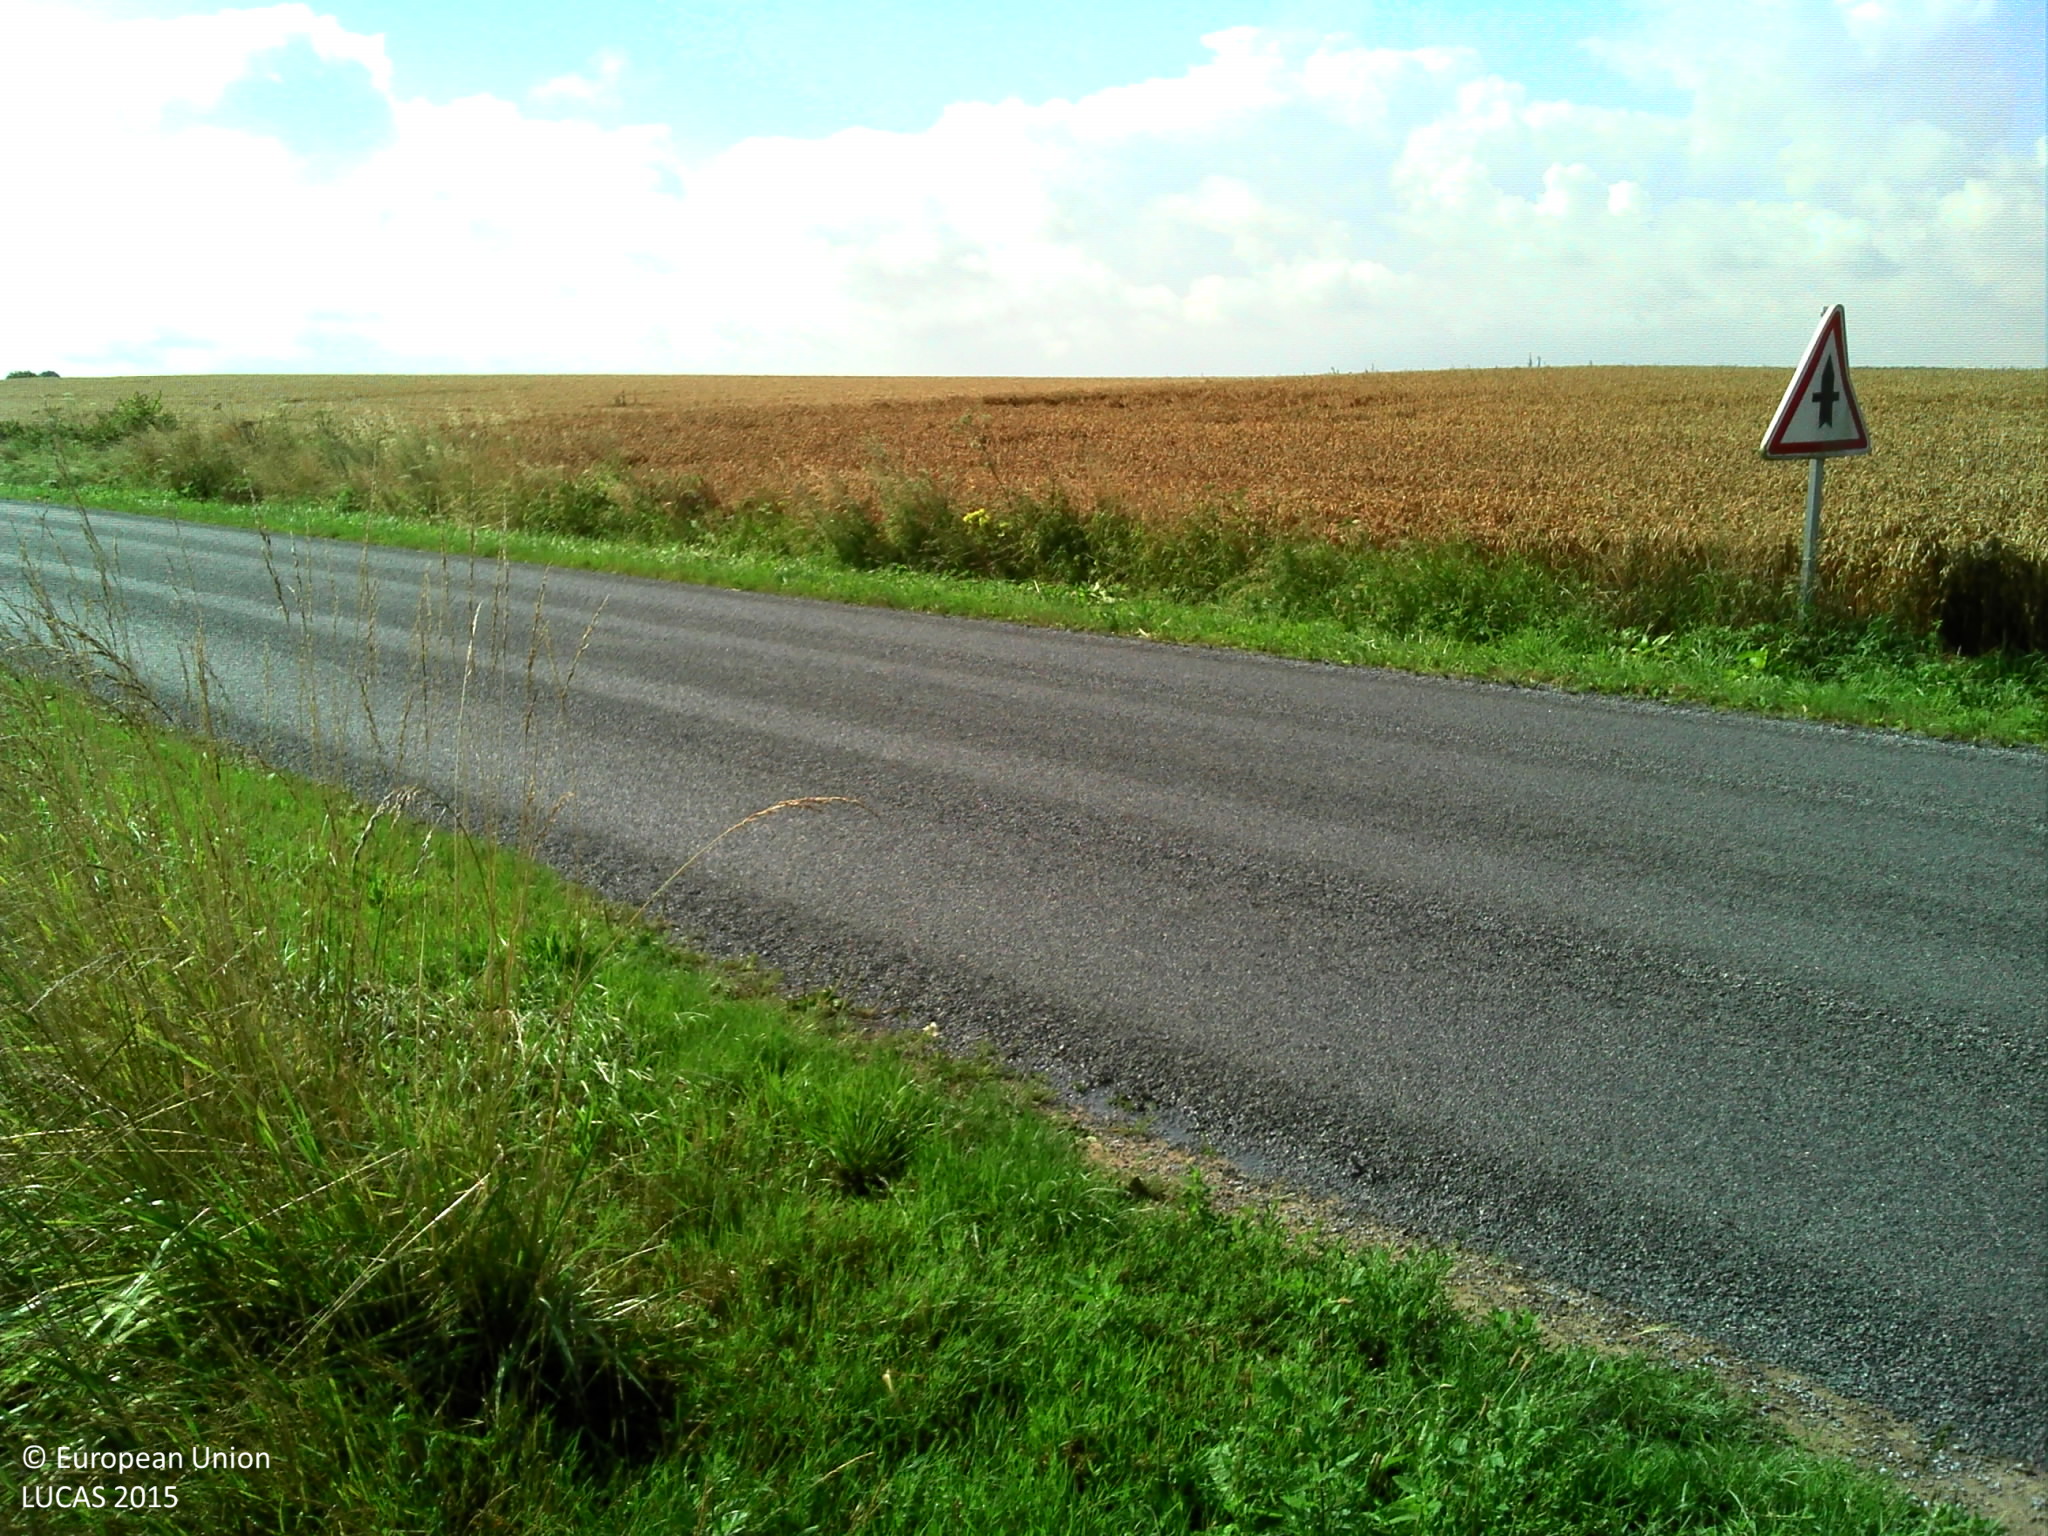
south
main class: Grassland
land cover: Grassland without tree/shrub cover
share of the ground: > 75 %
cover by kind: herbaceous plants 100 %
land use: Agriculture (excluding fallow land and kitchen gardens)
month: July
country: FR
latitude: 50.2934
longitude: 3.6060
